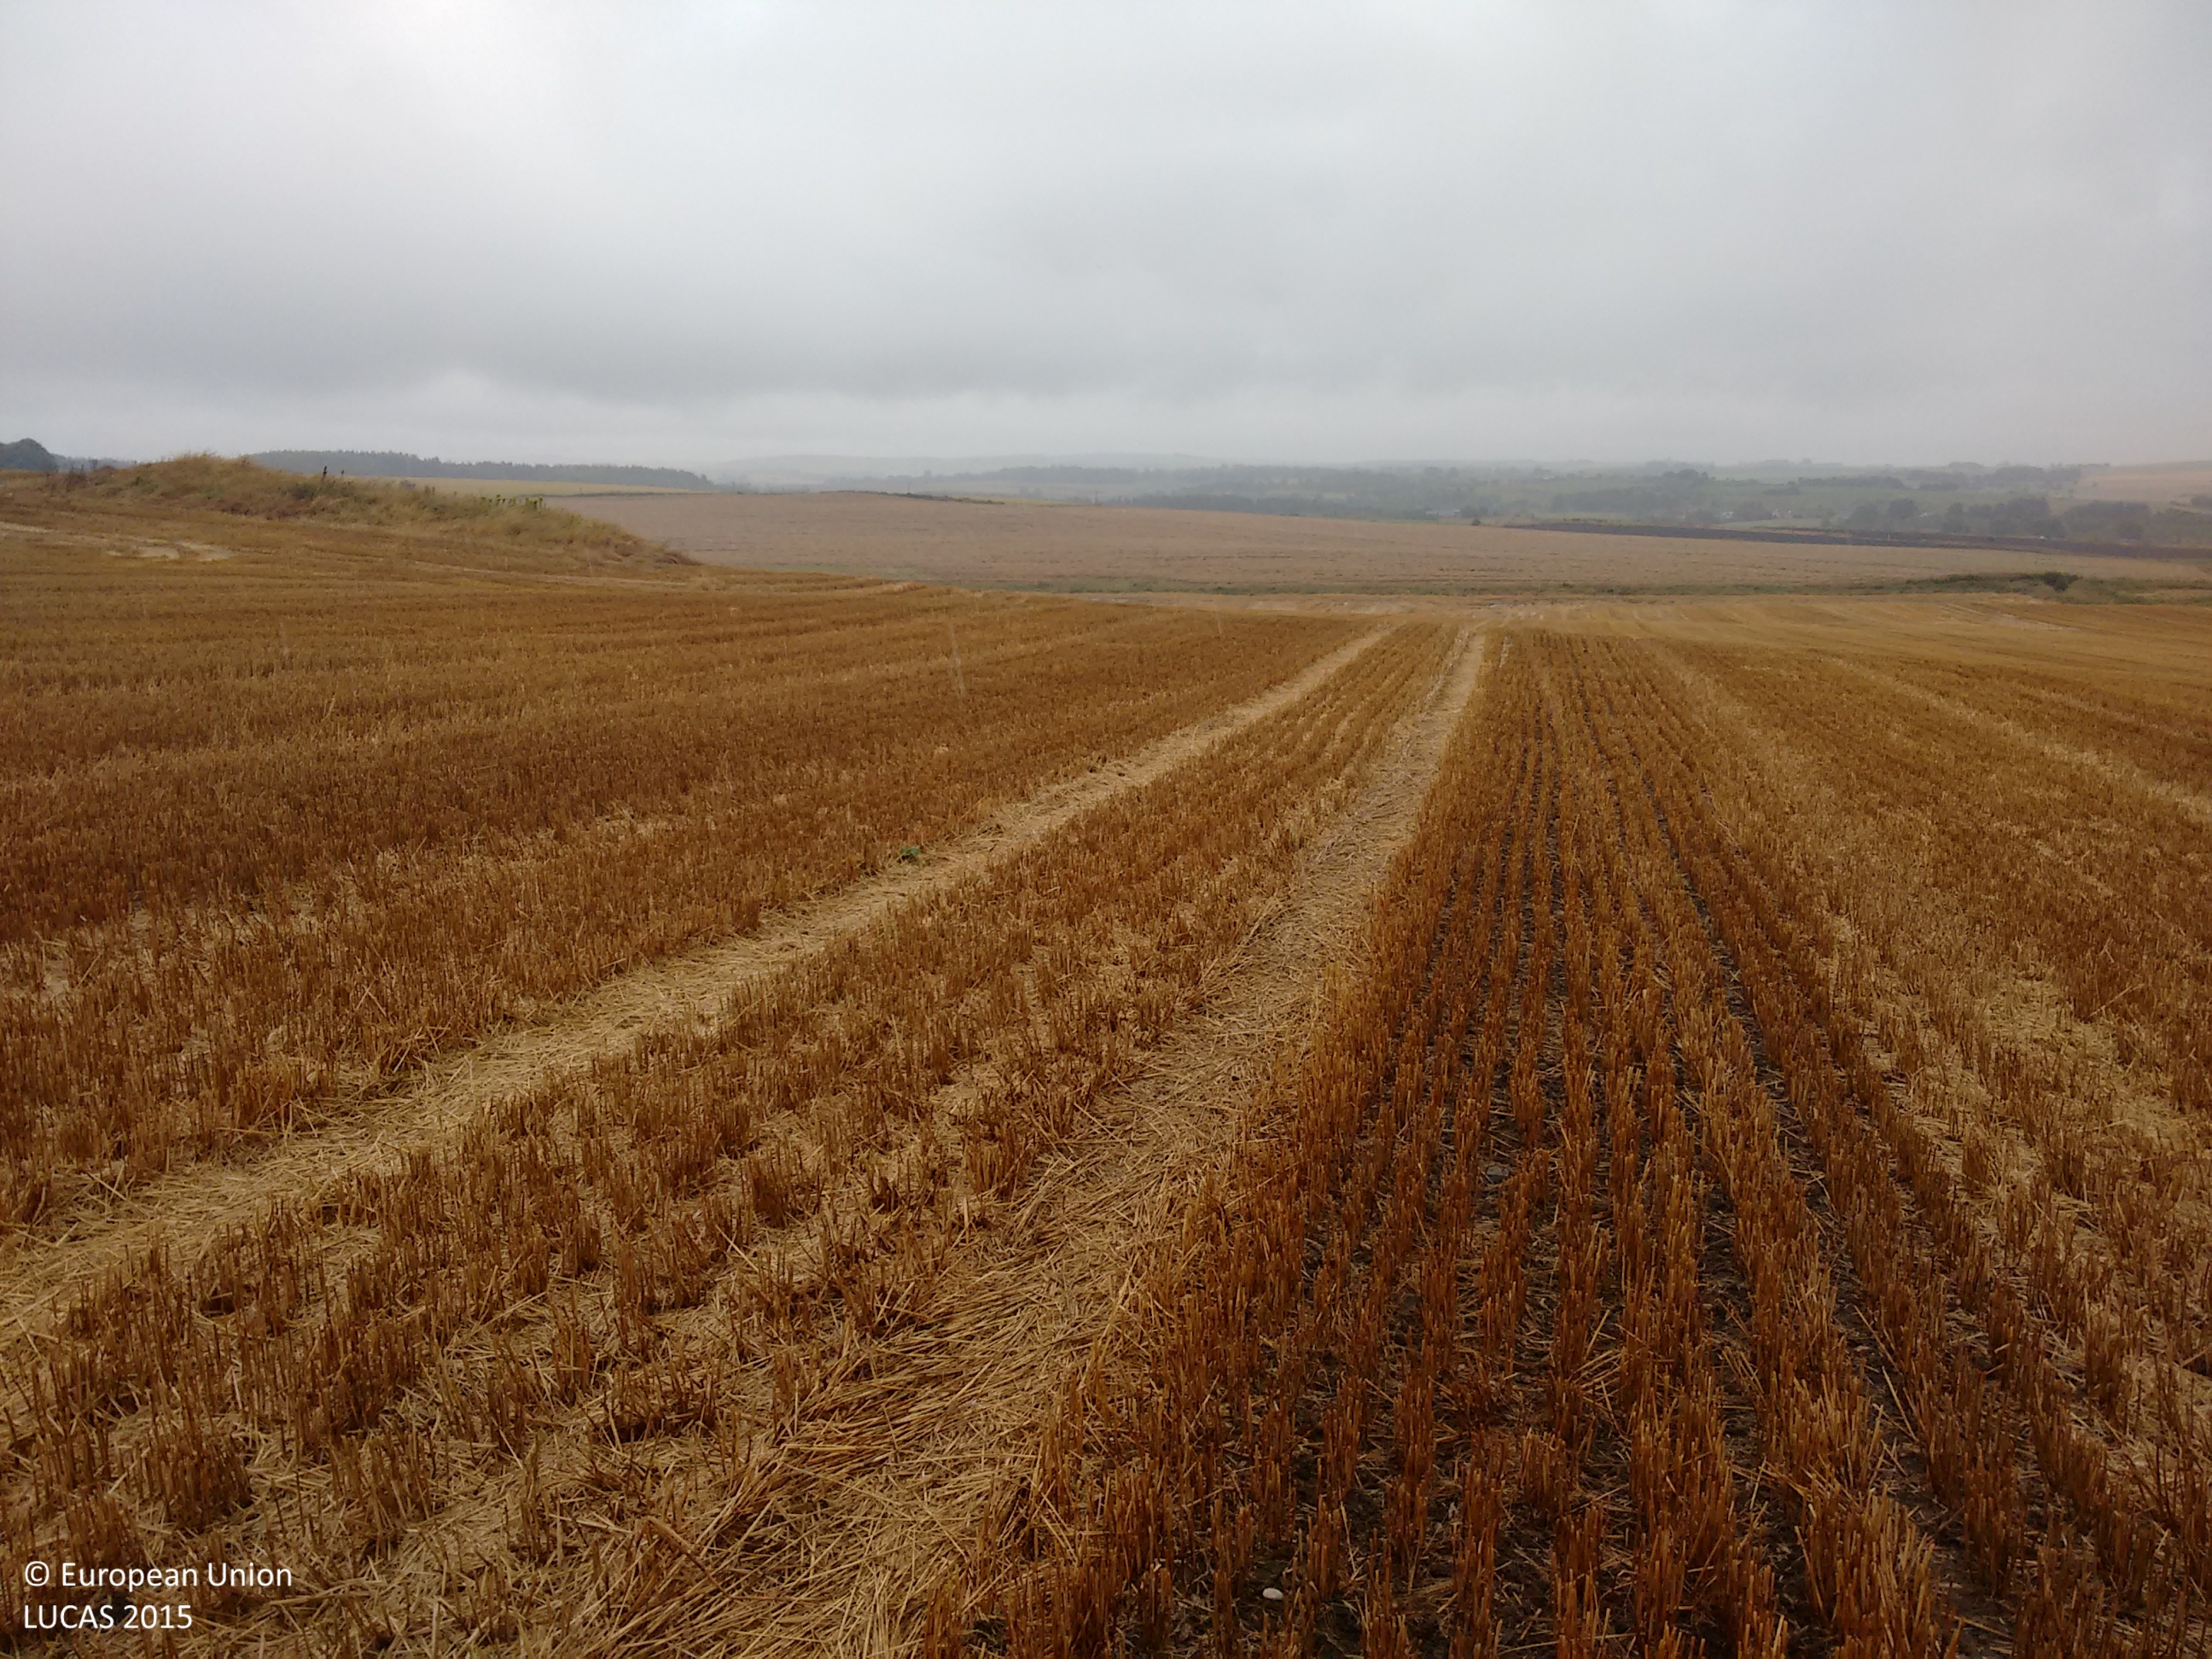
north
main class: Cropland
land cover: Barley
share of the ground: > 75 %
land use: Agriculture (excluding fallow land and kitchen gardens)
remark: Harvested field
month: August
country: GB
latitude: 57.3900
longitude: -2.1767
